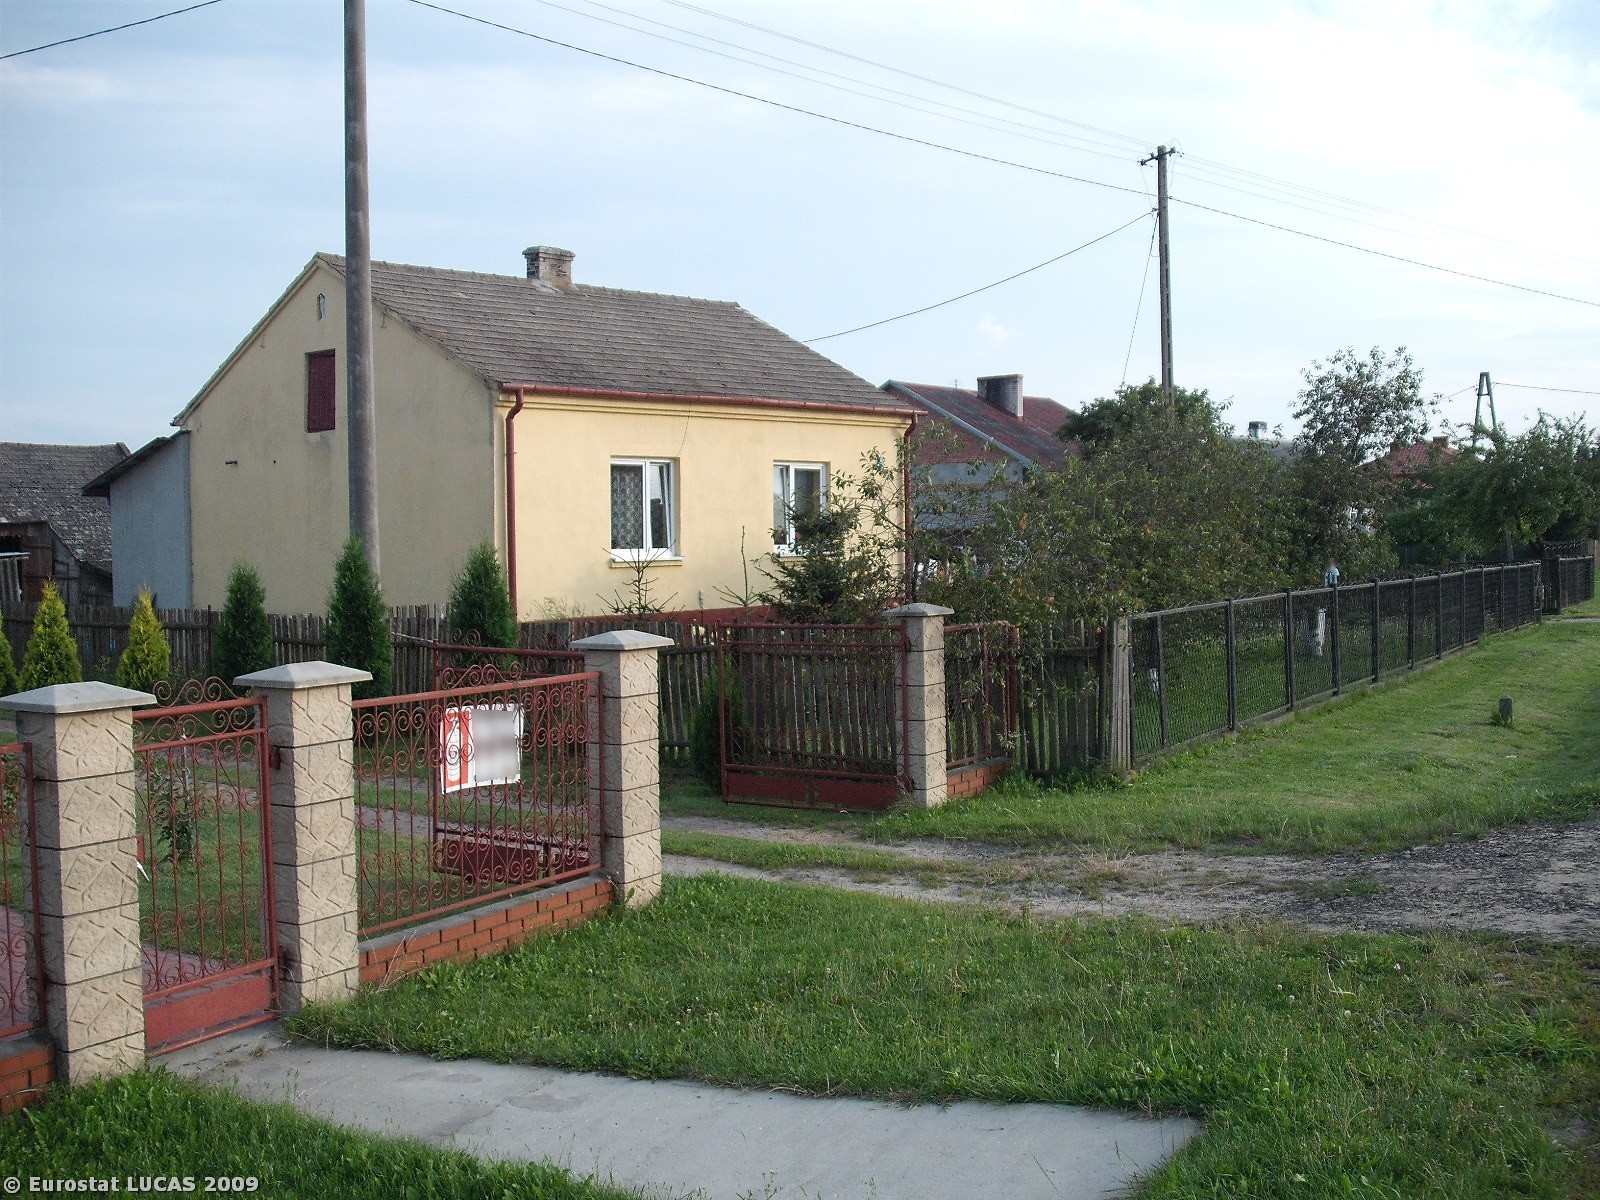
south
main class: Grassland
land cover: Grassland without tree/shrub cover
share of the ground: > 75 %
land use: Residential
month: July
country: PL
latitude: 50.6263
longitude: 21.2288
